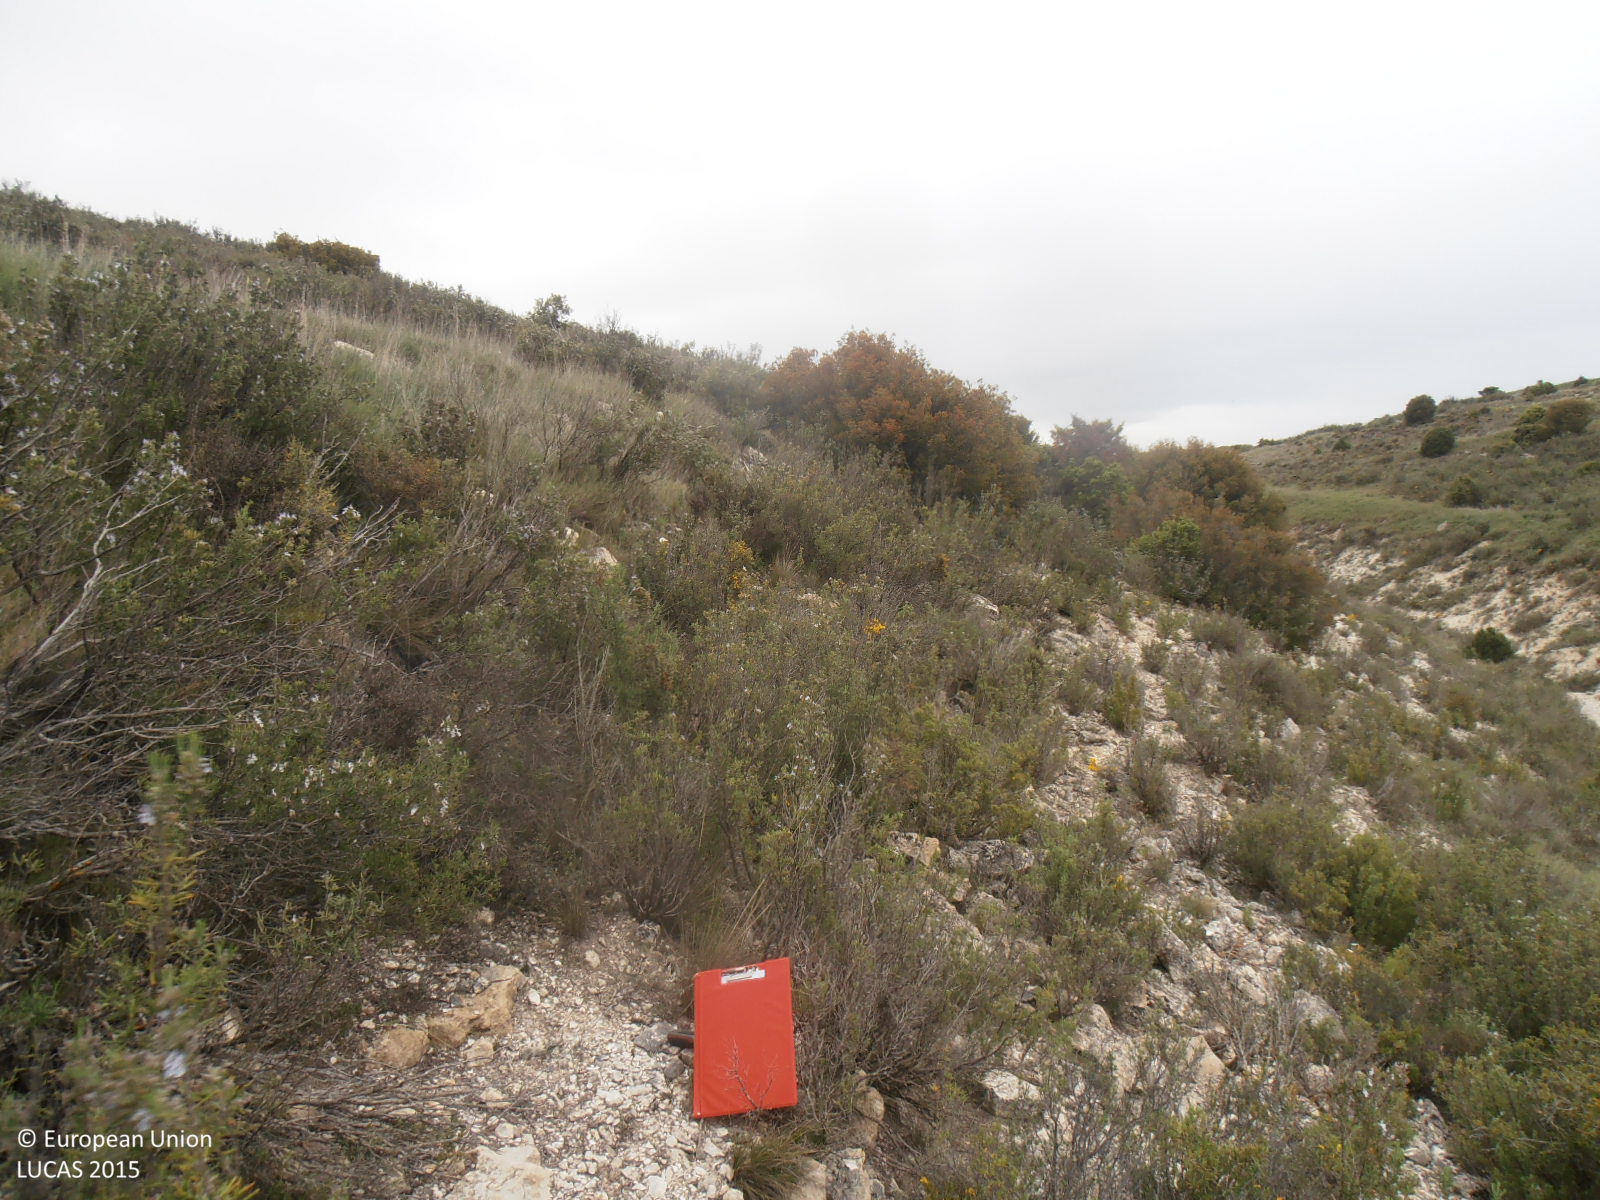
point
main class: Shrubland
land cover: Shrubland without tree cover
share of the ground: > 75 %
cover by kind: shrubs 65 %, consolidated bare surface 25 %, herbaceous plants 10 %
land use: Semi-natural and natural areas not in use
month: May
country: ES
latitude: 41.4164
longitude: -0.9915
